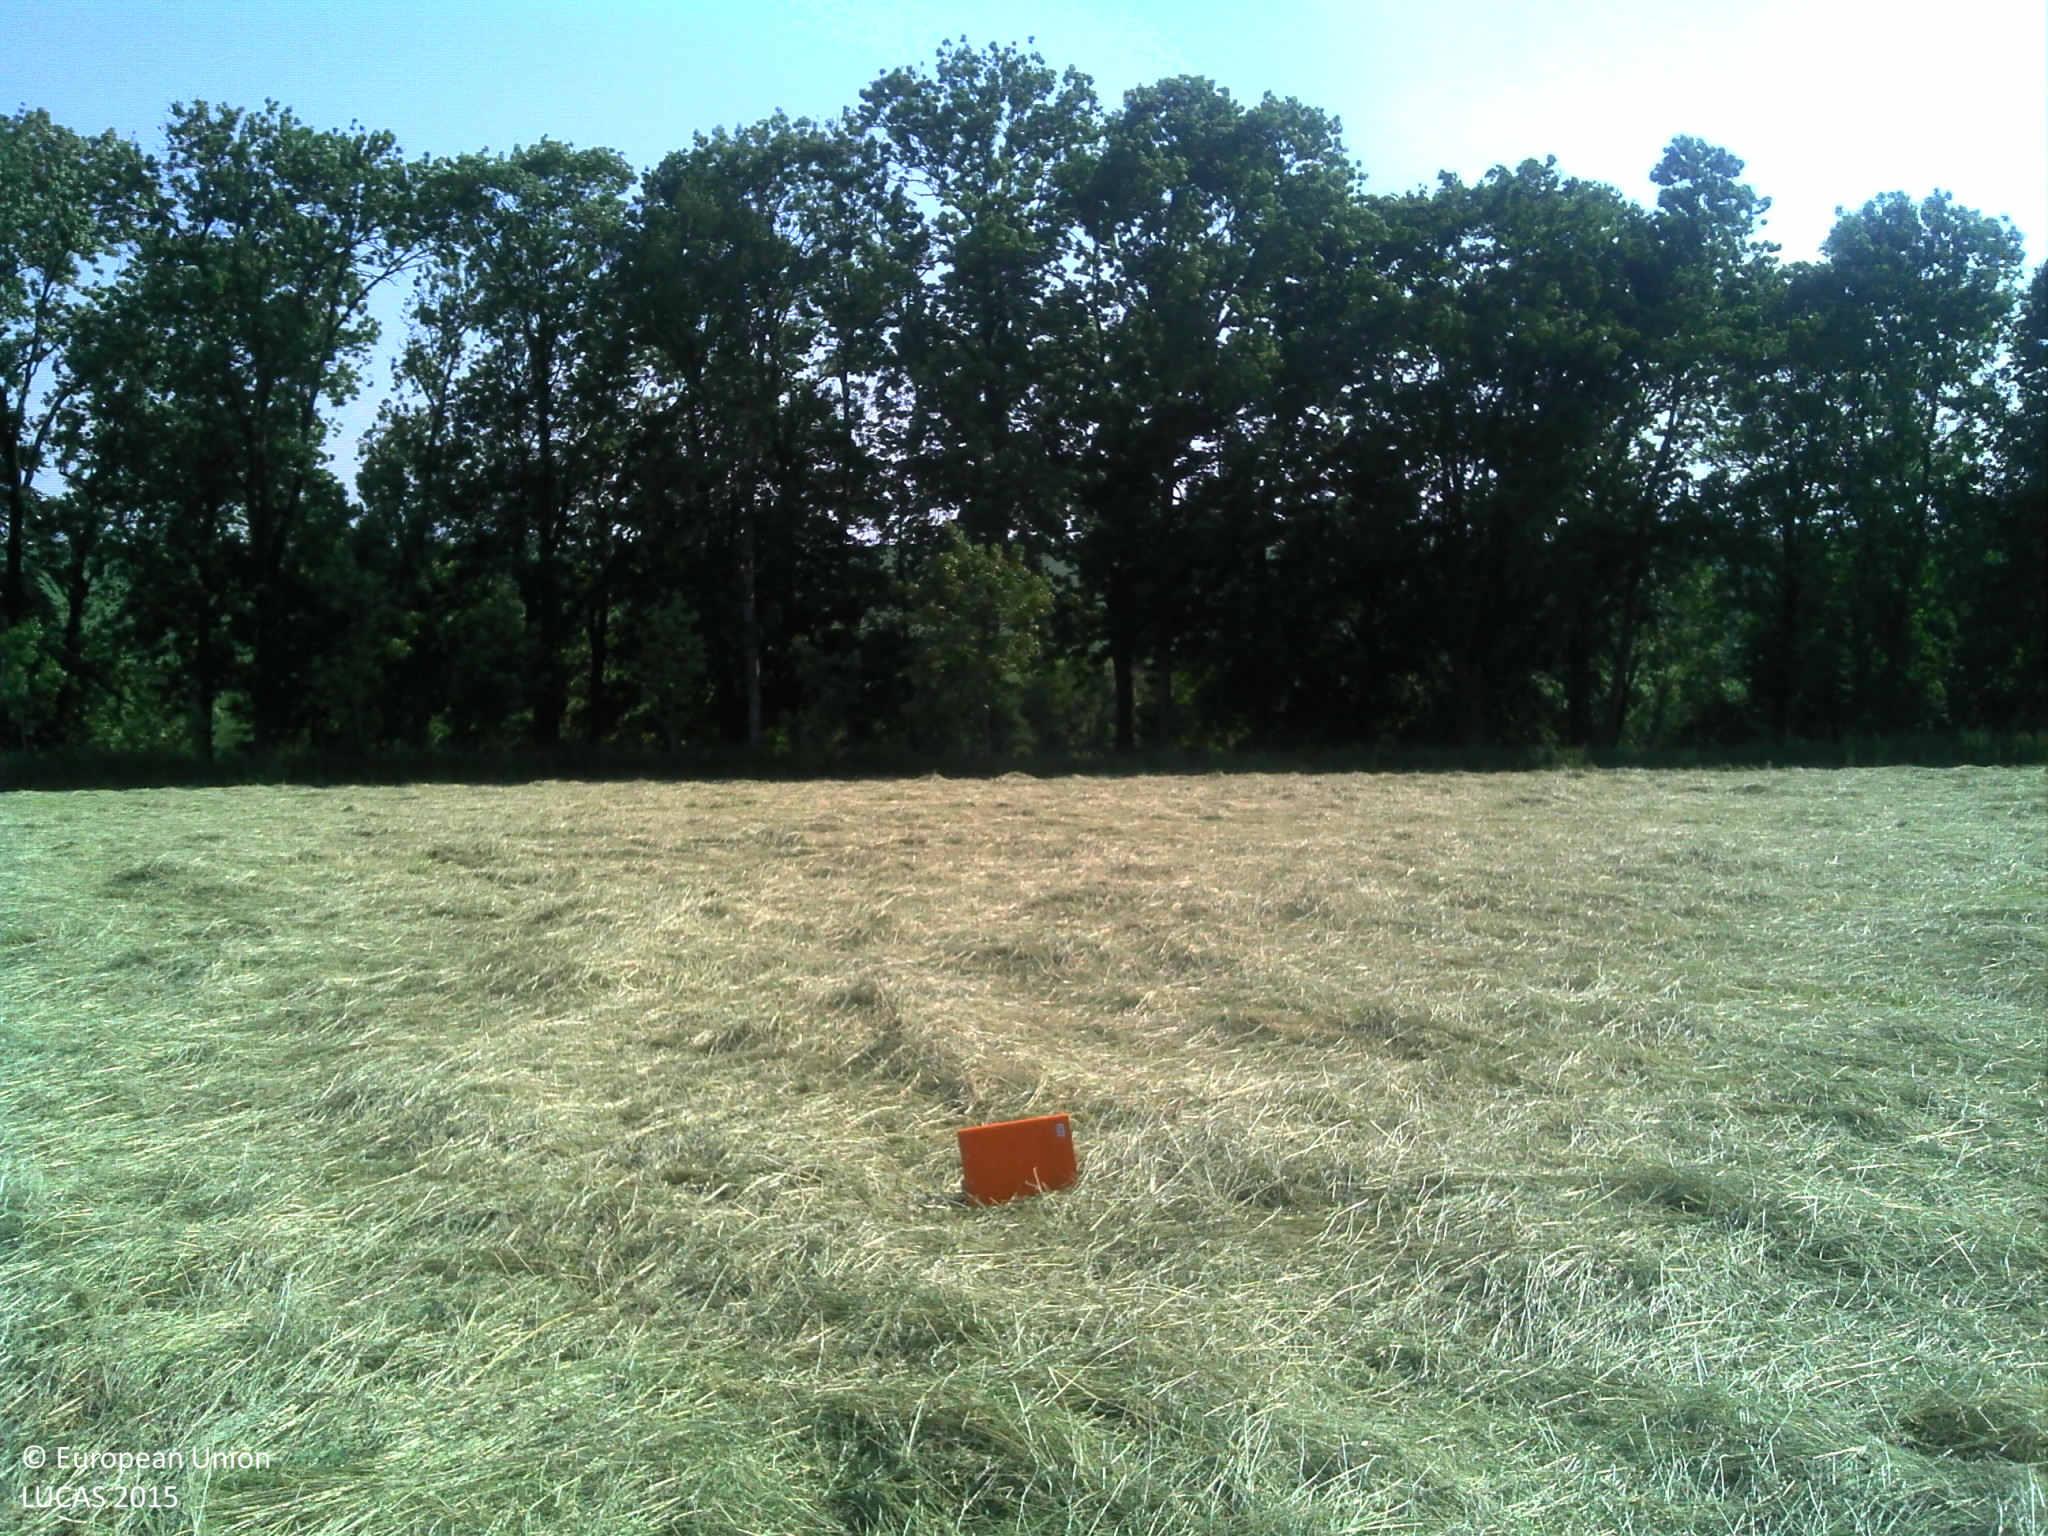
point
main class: Grassland
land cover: Grassland without tree/shrub cover
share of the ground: > 75 %
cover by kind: herbaceous plants 100 %
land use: Agriculture (excluding fallow land and kitchen gardens)
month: June
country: FR
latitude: 49.7787
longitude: 4.0928
